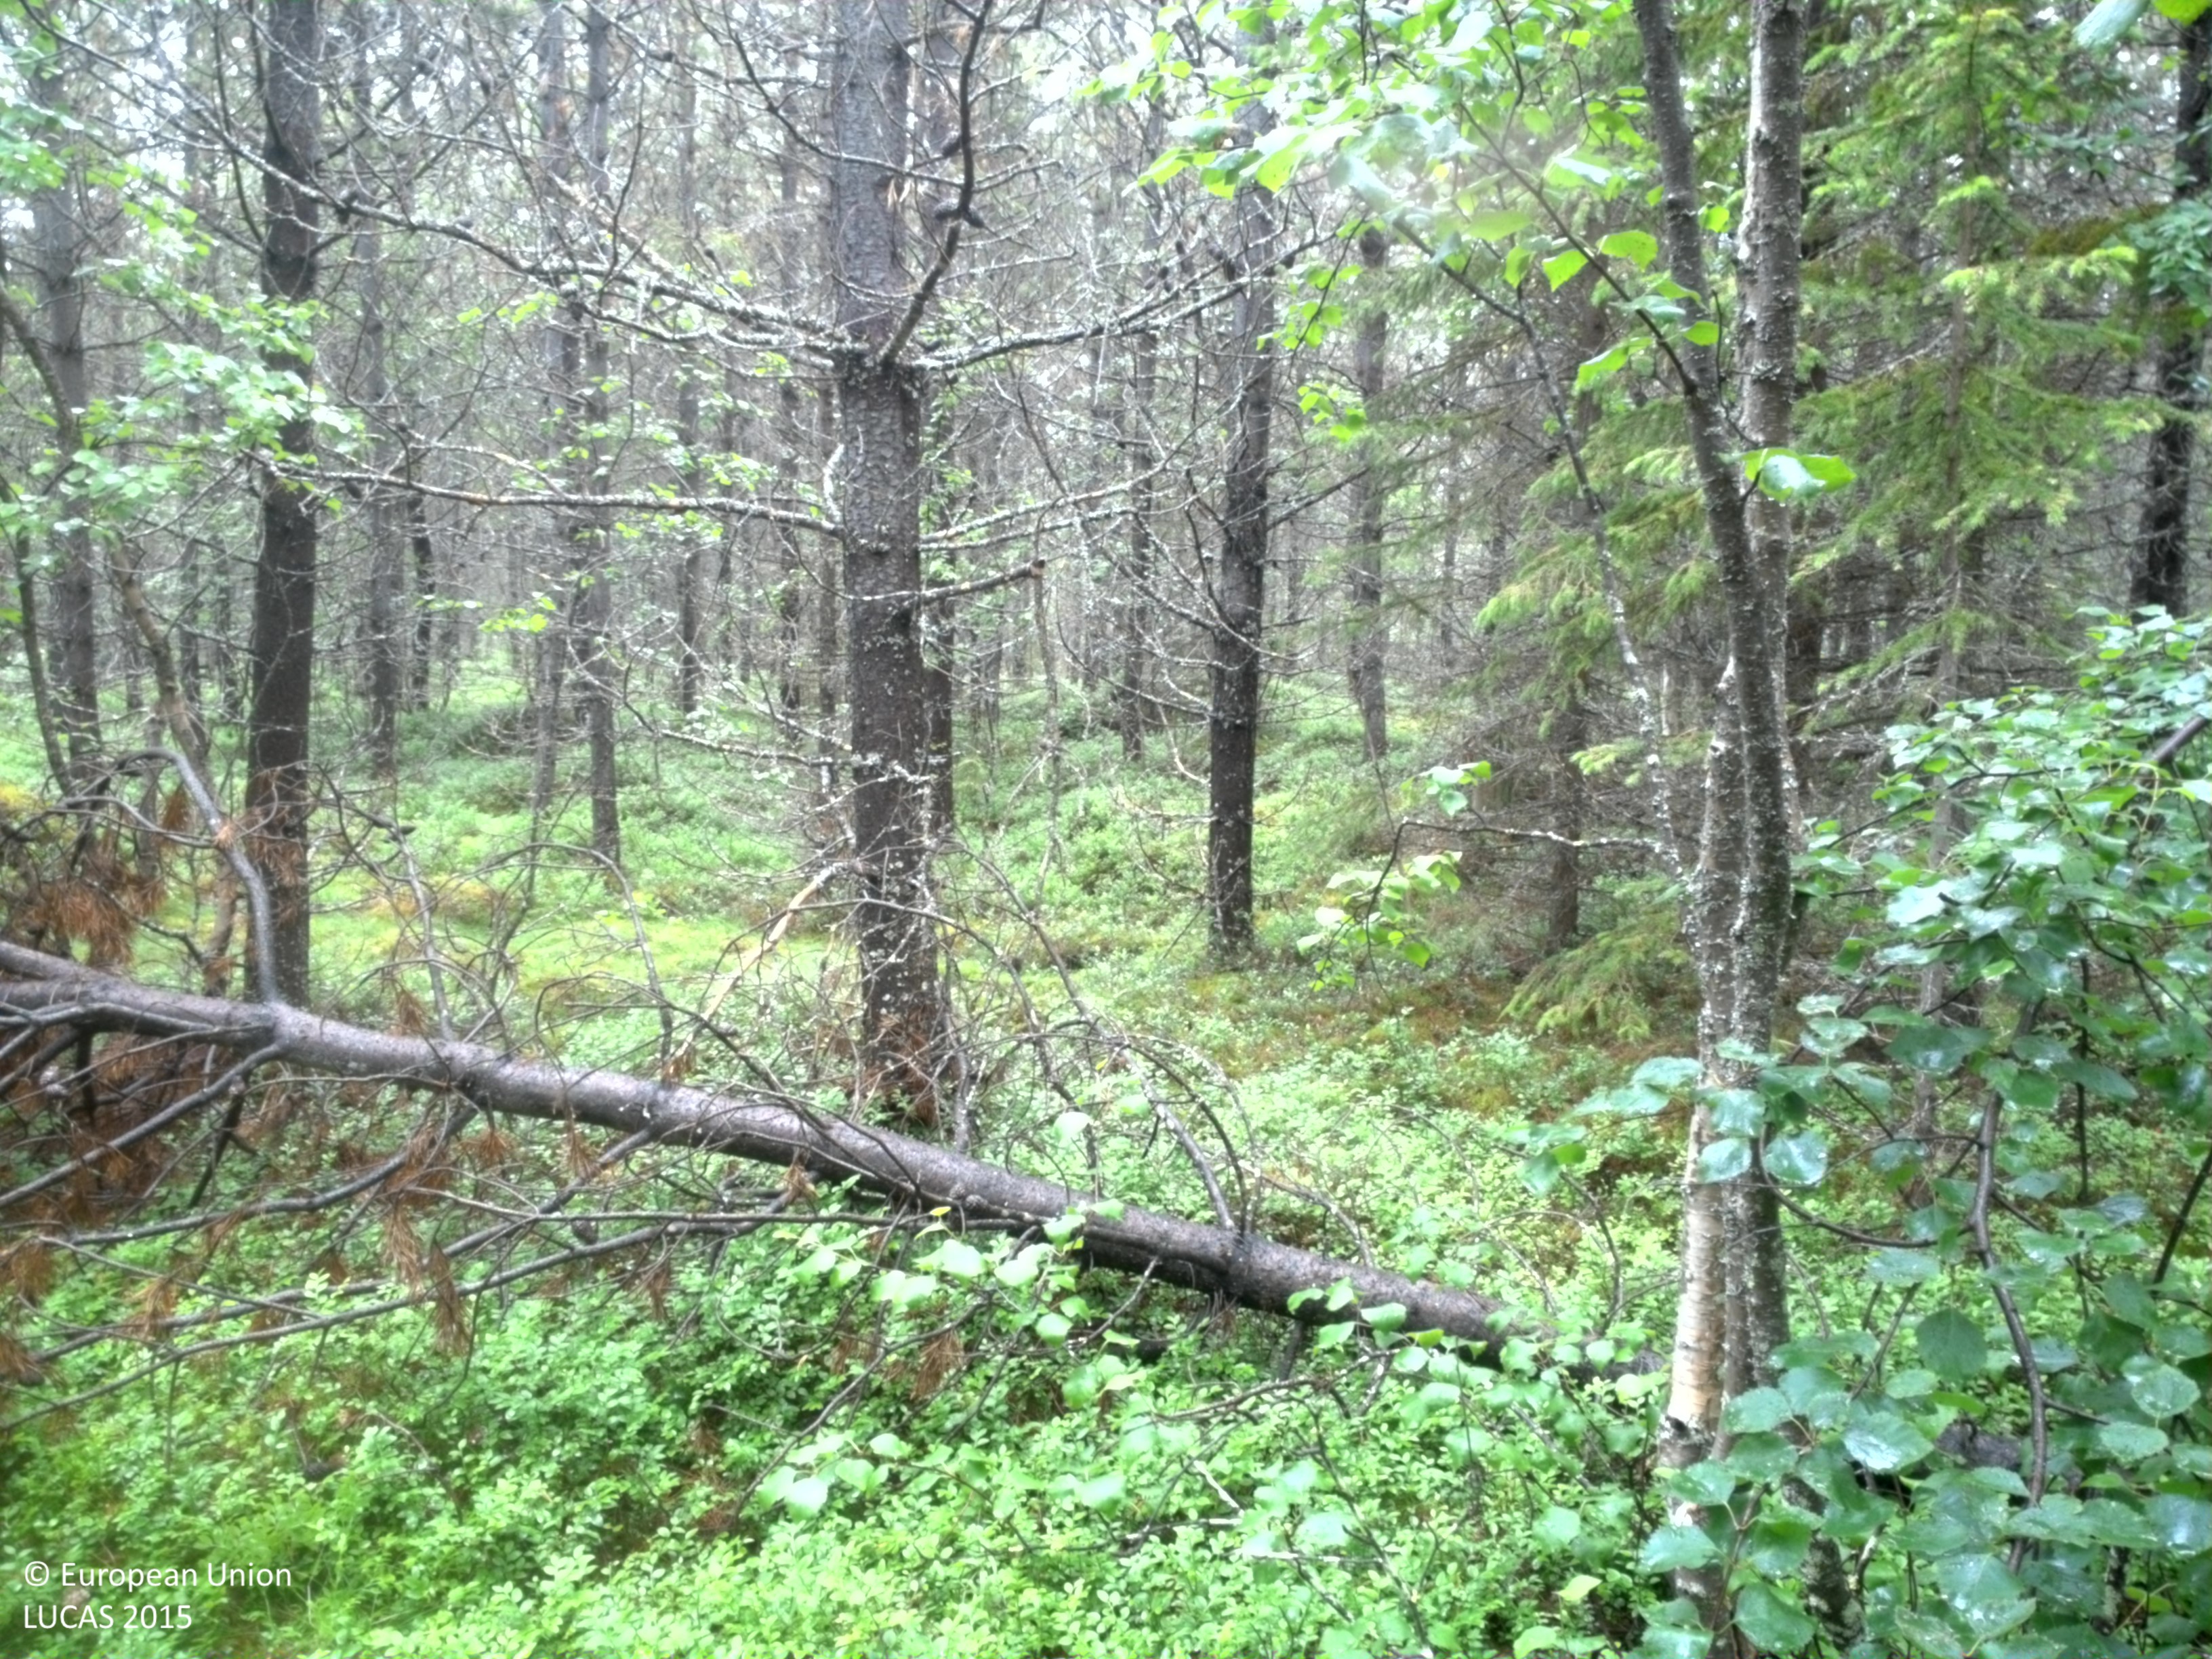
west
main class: Woodland
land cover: Pine dominated coniferous woodland
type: exotic forest
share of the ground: 50 - 75 %
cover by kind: coniferous forest trees 55 %, shrubs 40 %, broadleaved forest trees 5 %
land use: Forestry
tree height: > 5 m
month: July
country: SE
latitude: 66.1175
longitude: 20.4300
